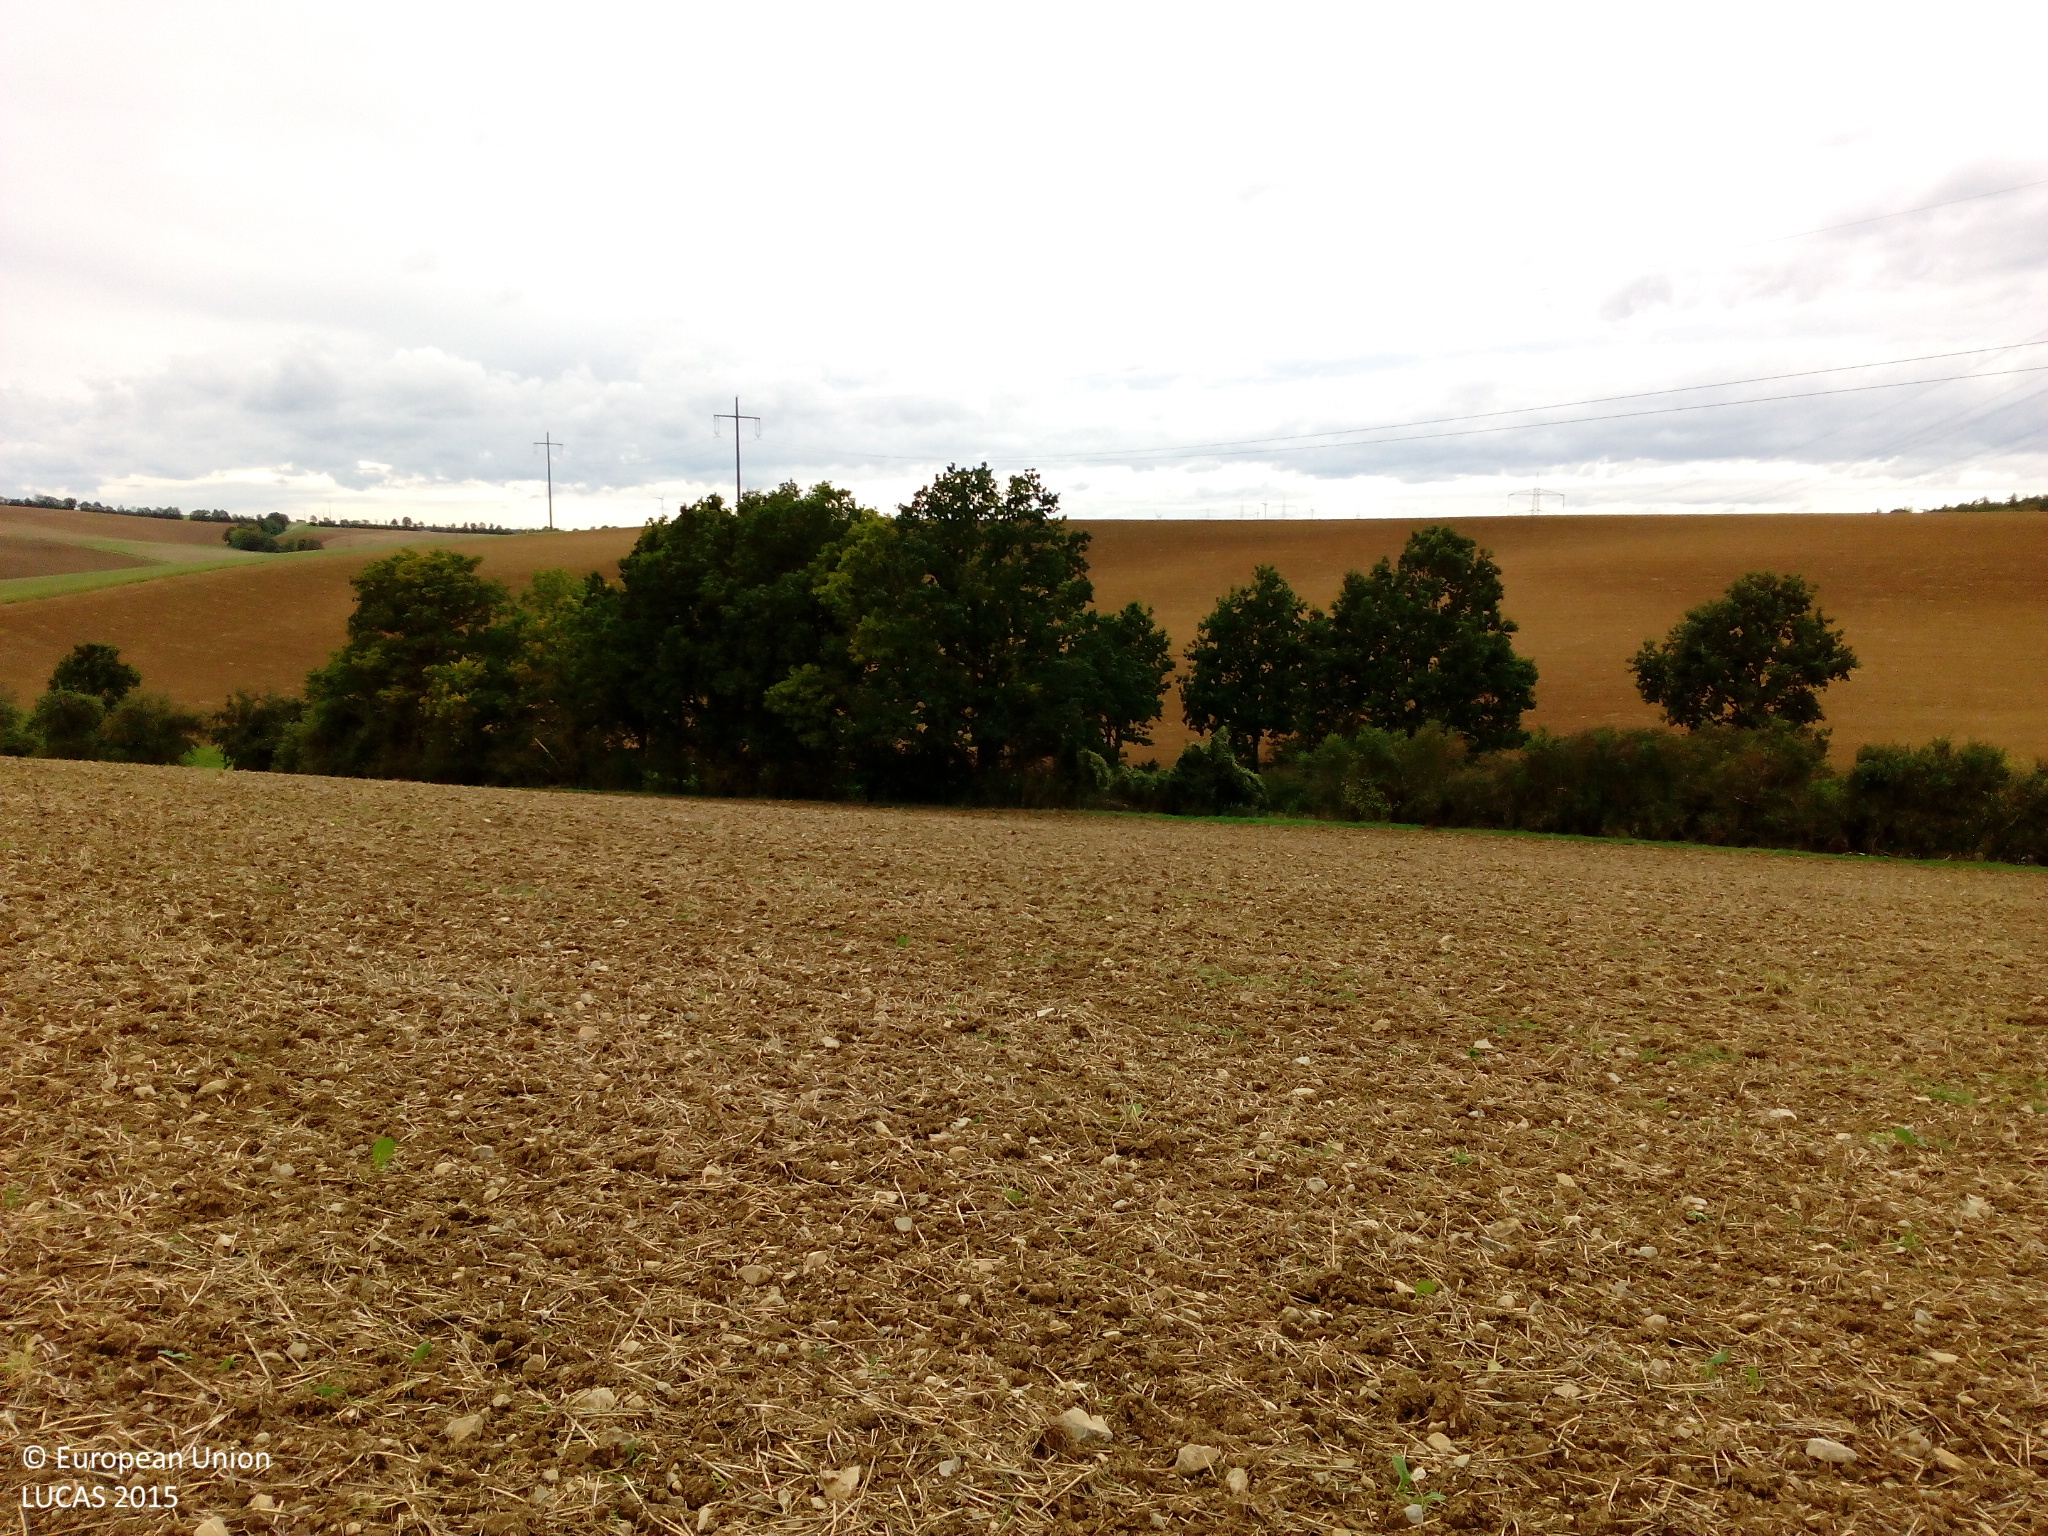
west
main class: Cropland
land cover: Common wheat
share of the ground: 10 - 25 %
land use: Agriculture (excluding fallow land and kitchen gardens)
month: September
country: DE
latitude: 49.9864
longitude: 9.9303
